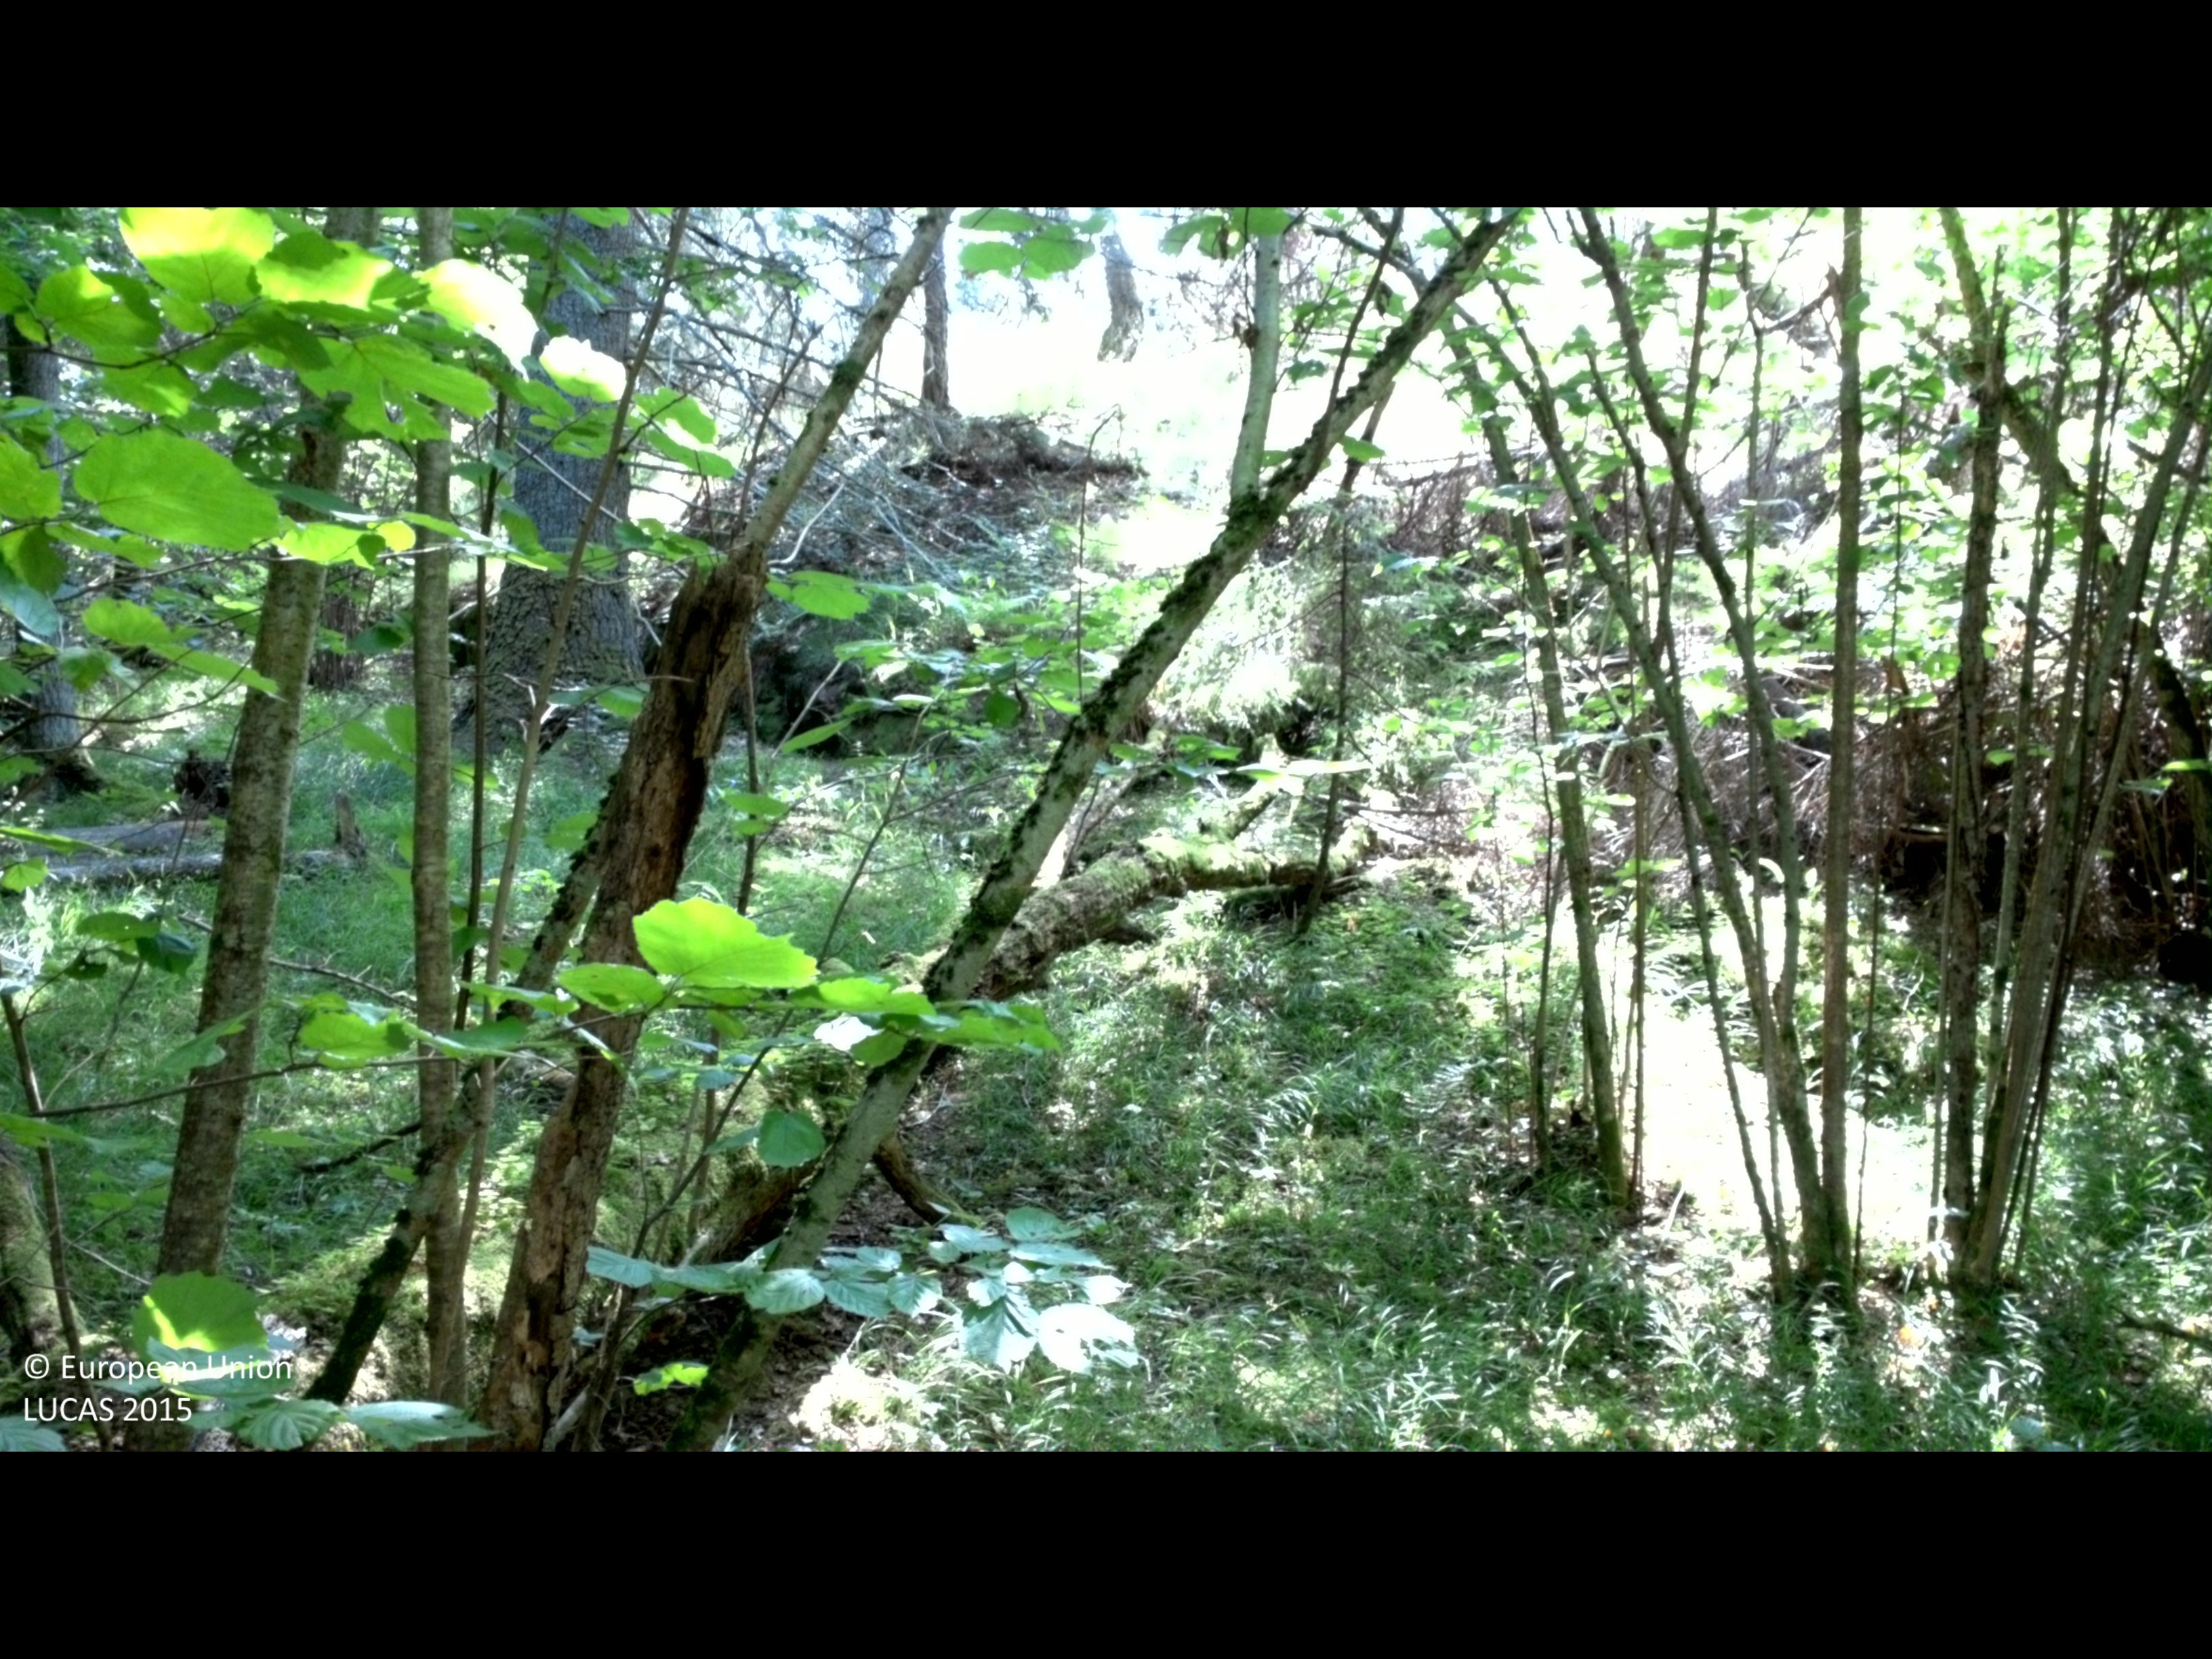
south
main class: Woodland
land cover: Spruce dominated mixed woodland
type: hemiboreal forest and nemoral coniferous forest and mixed broadleaved-coniferous forest
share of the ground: > 75 %
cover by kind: coniferous forest trees 40 %, broadleaved forest trees 35 %, shrubs 15 %, herbaceous plants 5 %, lichens and mosses 5 %
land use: Forestry
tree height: > 5 m
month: July
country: SE
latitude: 58.4090
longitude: 16.7919
